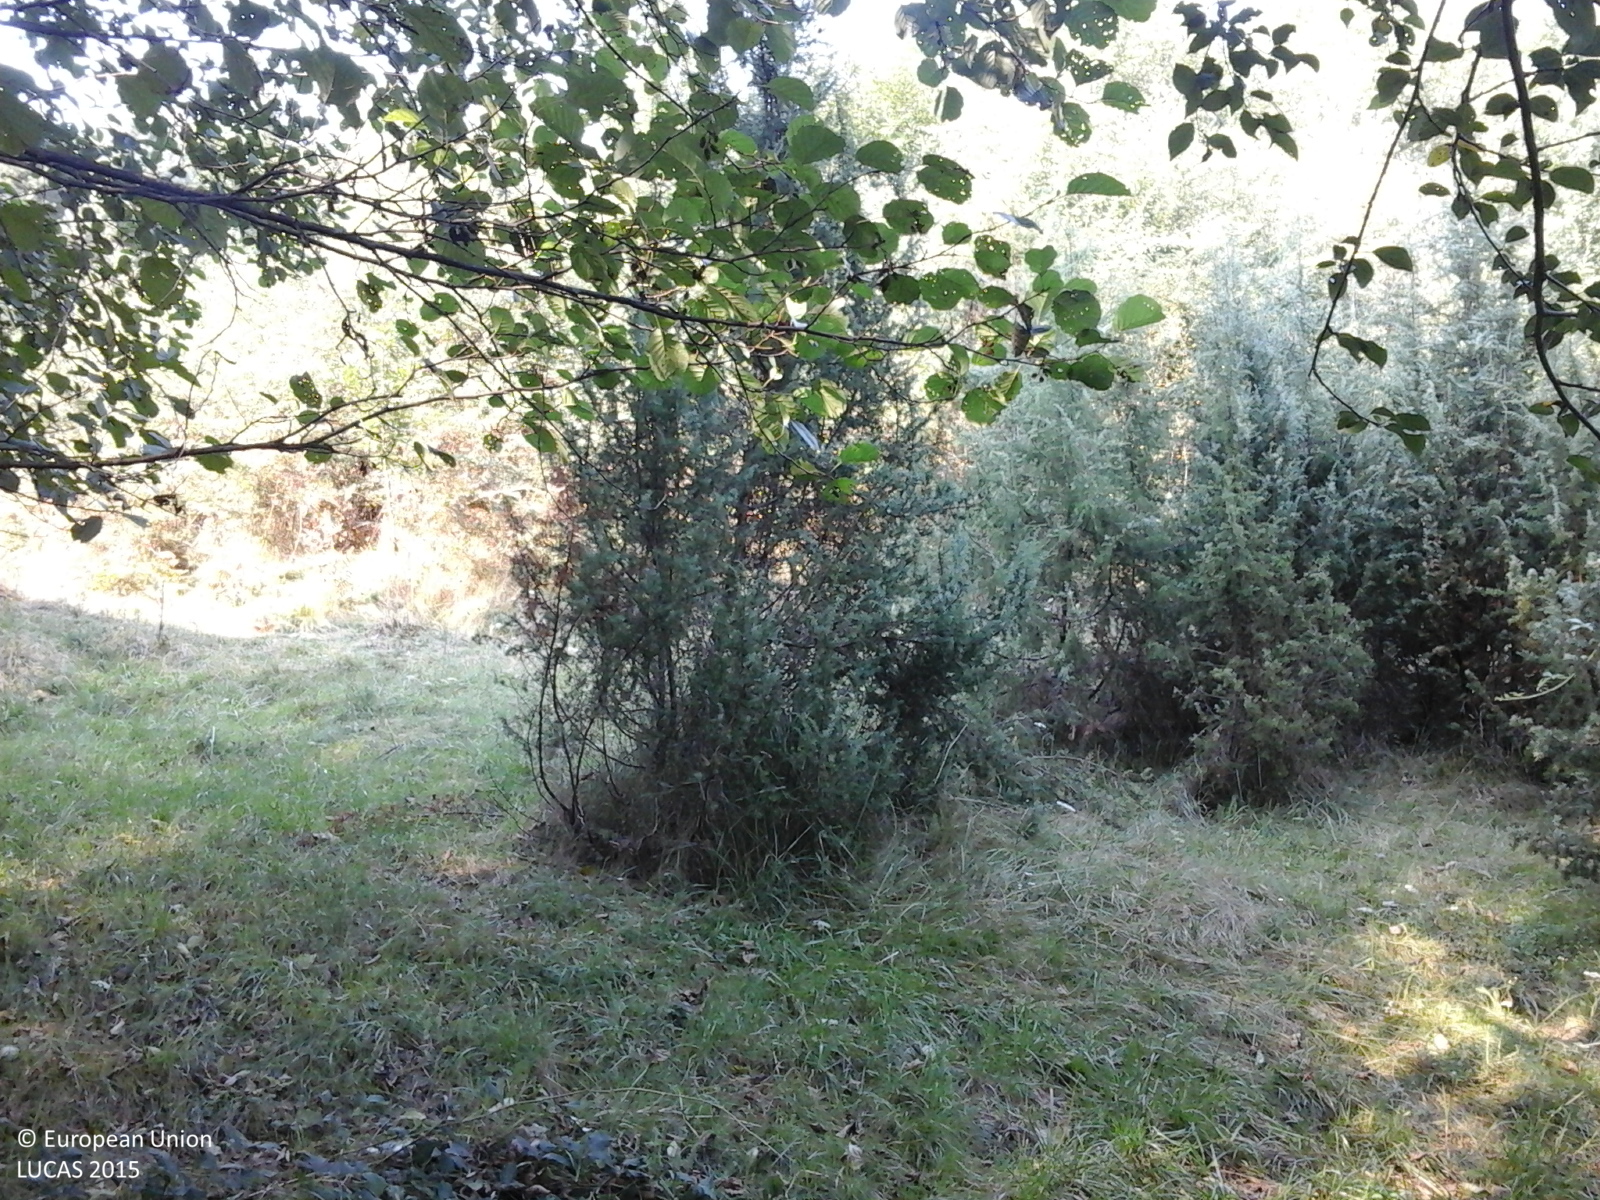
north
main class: Woodland
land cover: Other mixed woodland
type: beech forest
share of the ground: > 75 %
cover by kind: broadleaved forest trees 70 %, coniferous forest trees 30 %
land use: Forestry
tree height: > 5 m
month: August
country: RO
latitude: 46.3066
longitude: 22.5023
